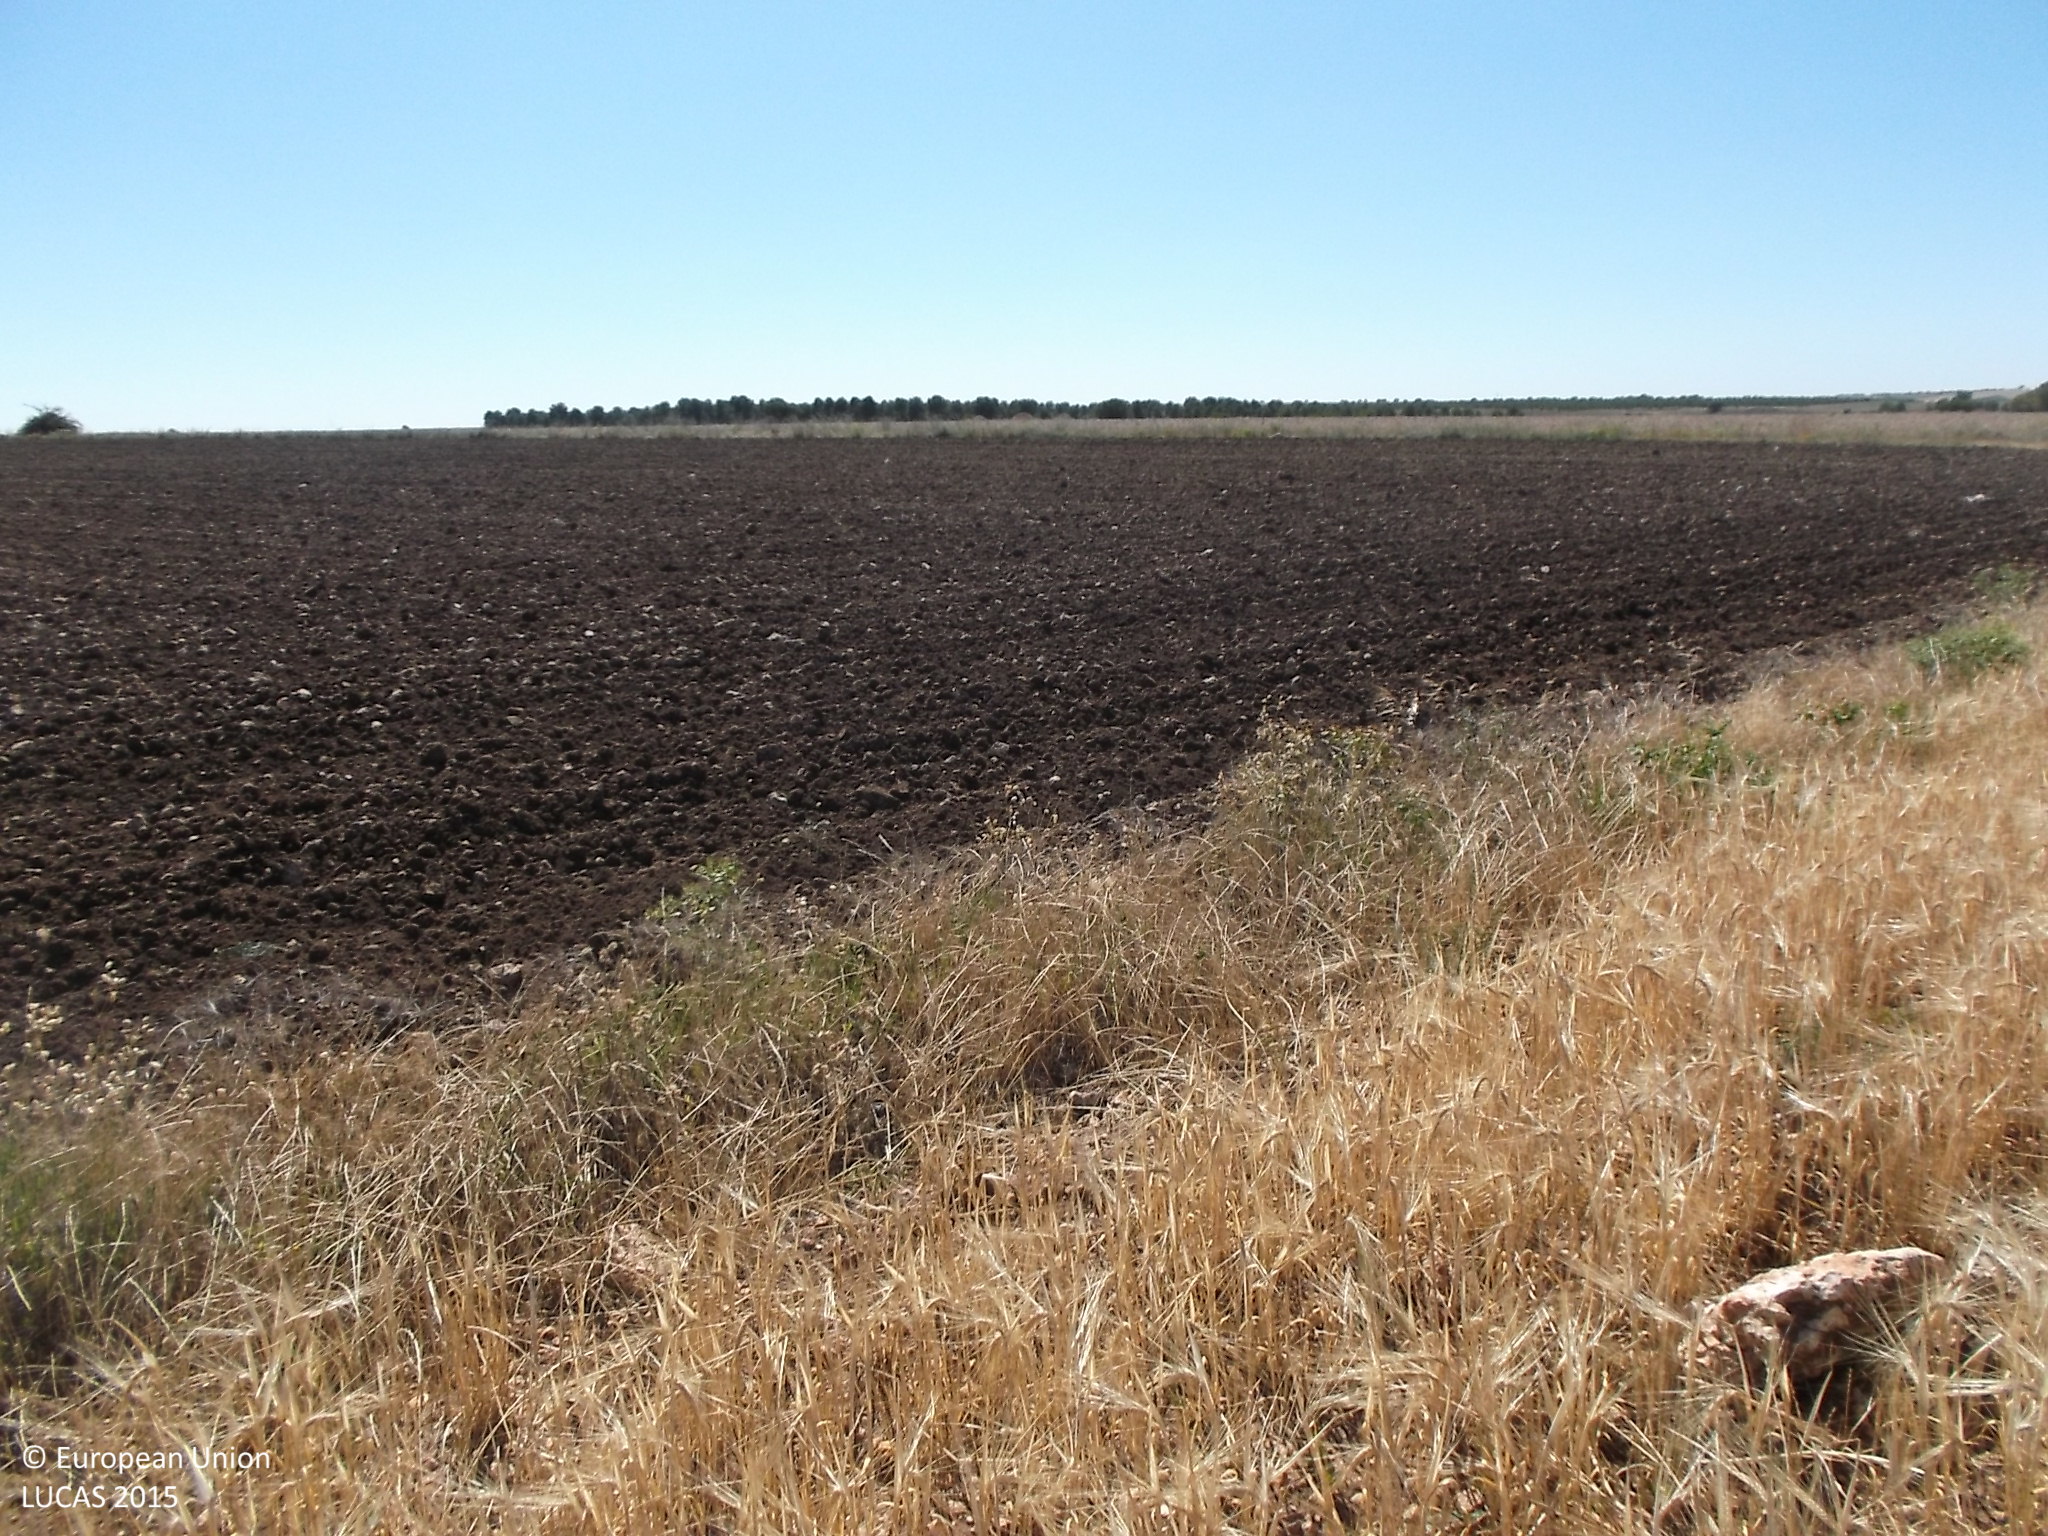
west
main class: Cropland
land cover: Barley
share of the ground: > 75 %
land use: Agriculture (excluding fallow land and kitchen gardens)
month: June
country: ES
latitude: 41.3705
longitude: -5.3197
